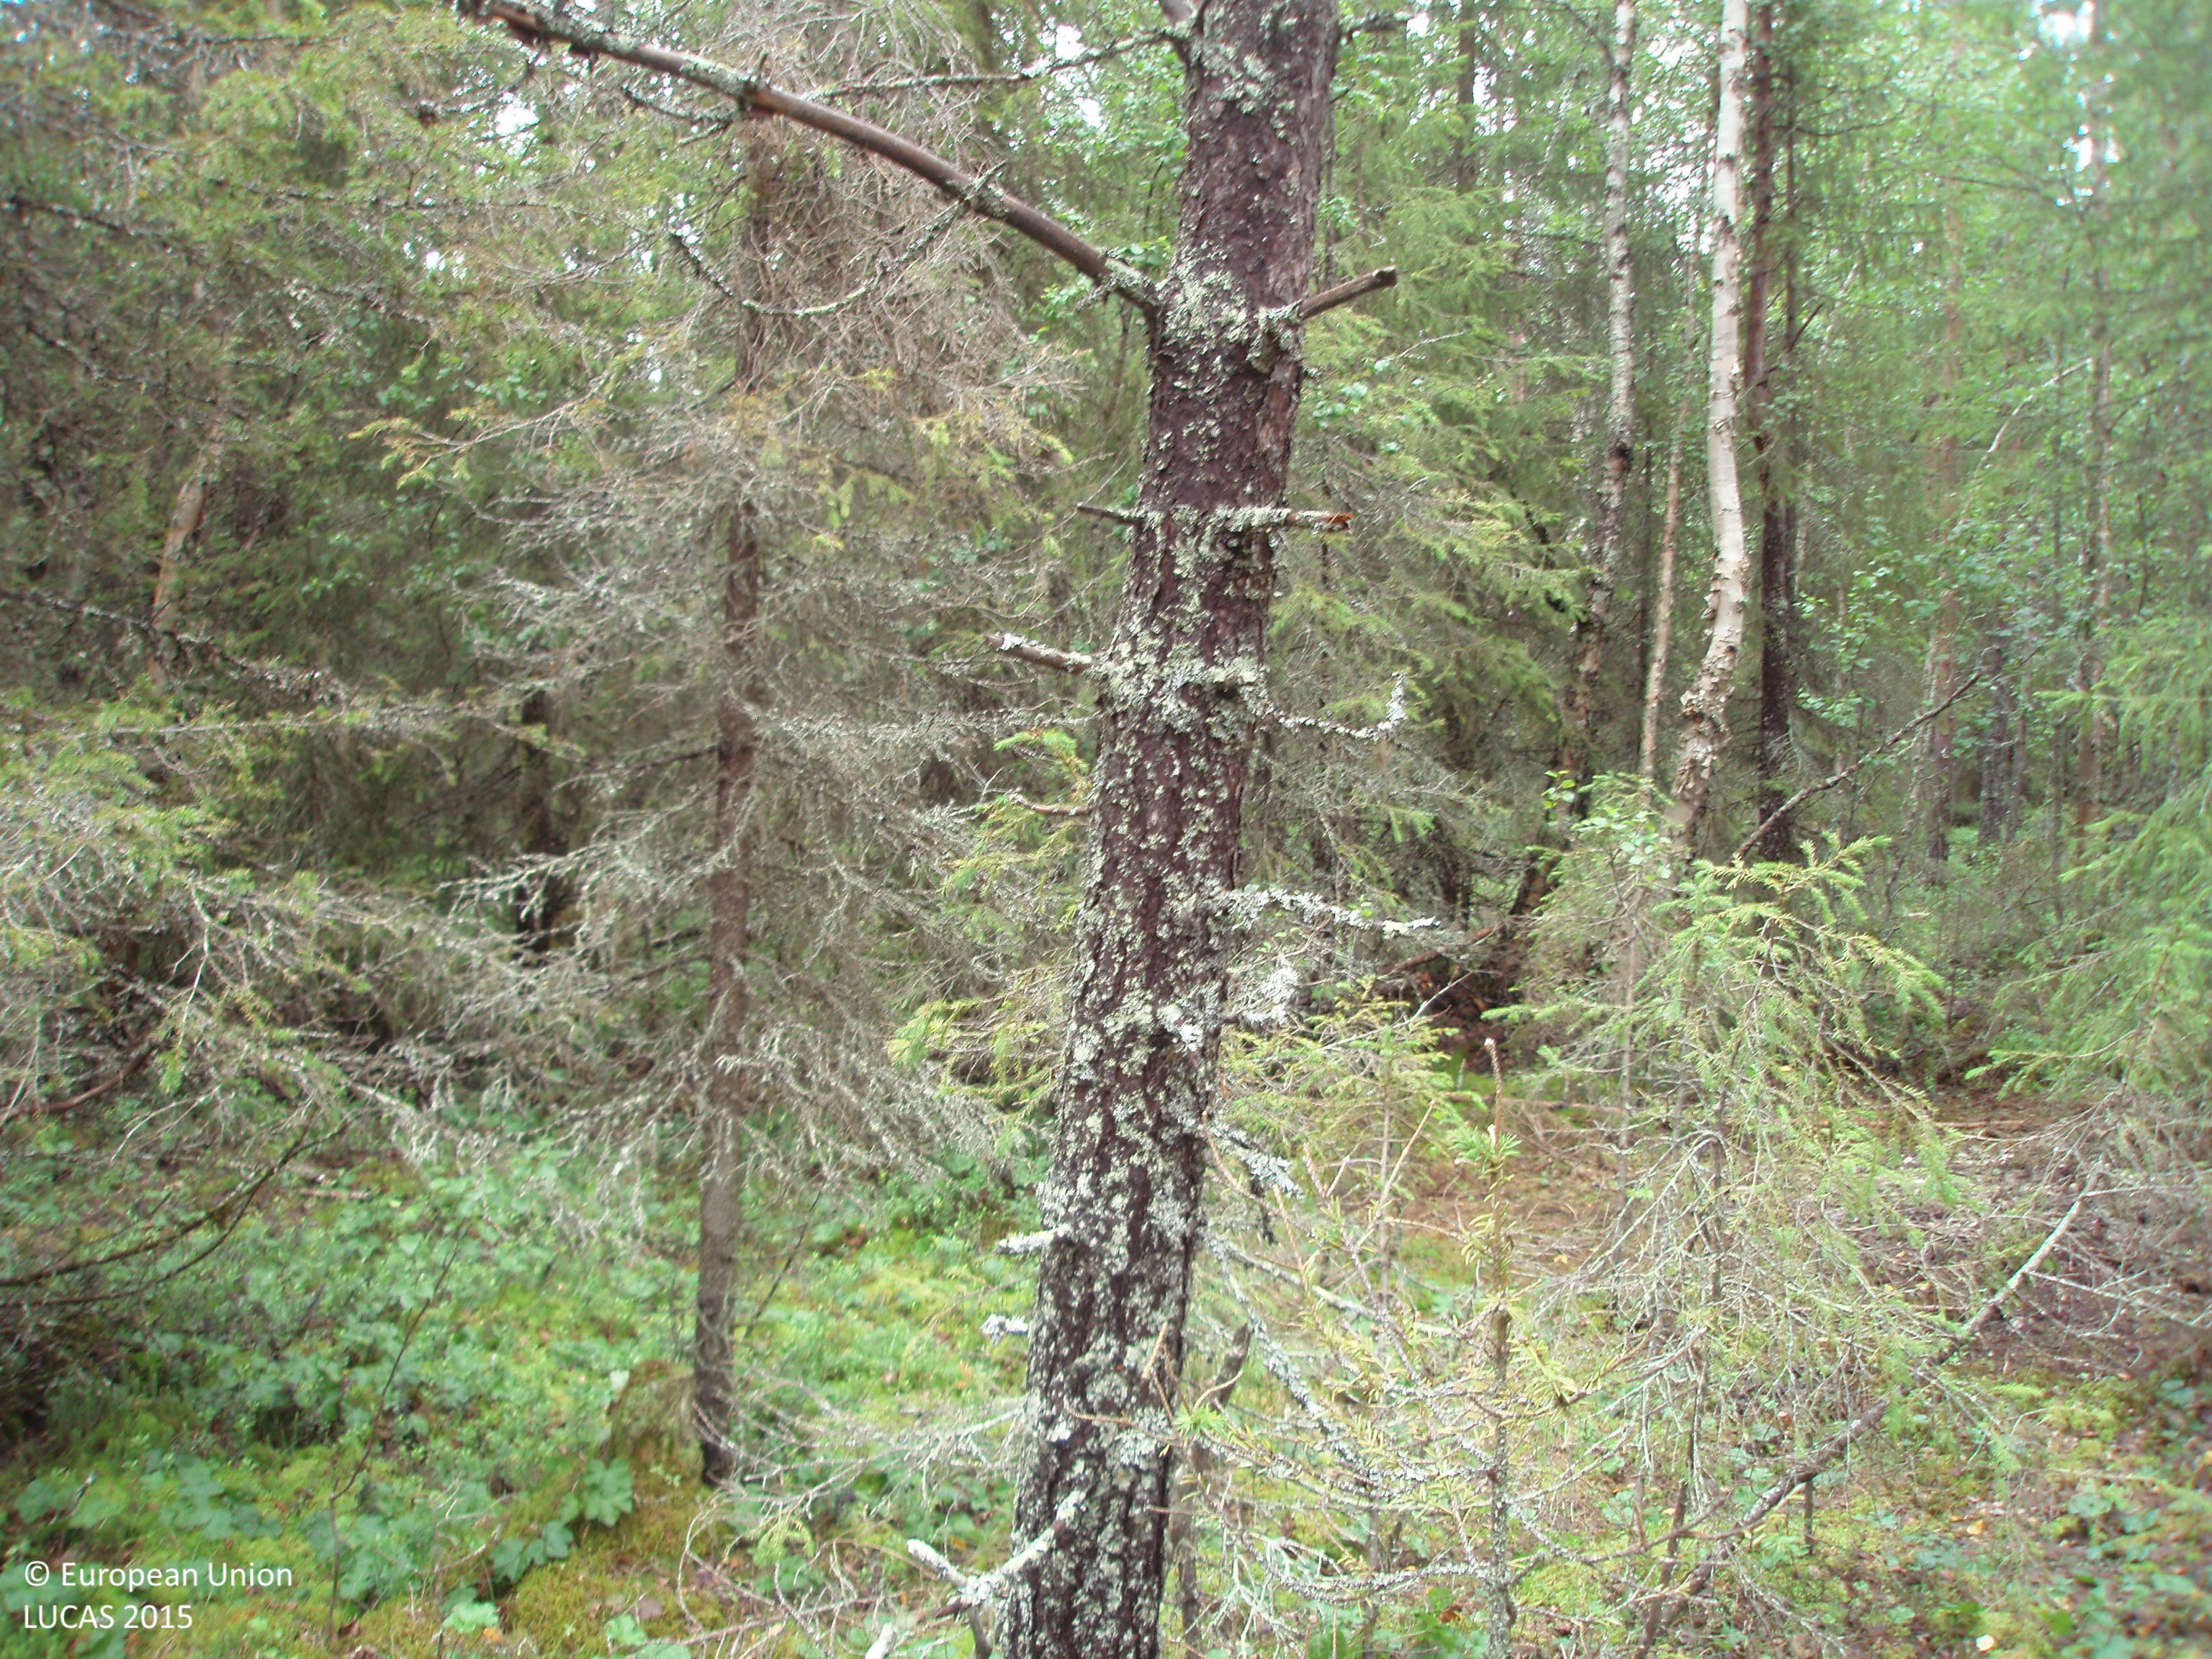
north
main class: Woodland
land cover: Spruce dominated coniferous woodland
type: boreal forest
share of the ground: > 75 %
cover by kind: coniferous forest trees 65 %, broadleaved forest trees 20 %, shrubs 10 %, herbaceous plants 5 %
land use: Forestry
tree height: > 5 m
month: July
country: FI
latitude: 65.9738
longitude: 27.9426
